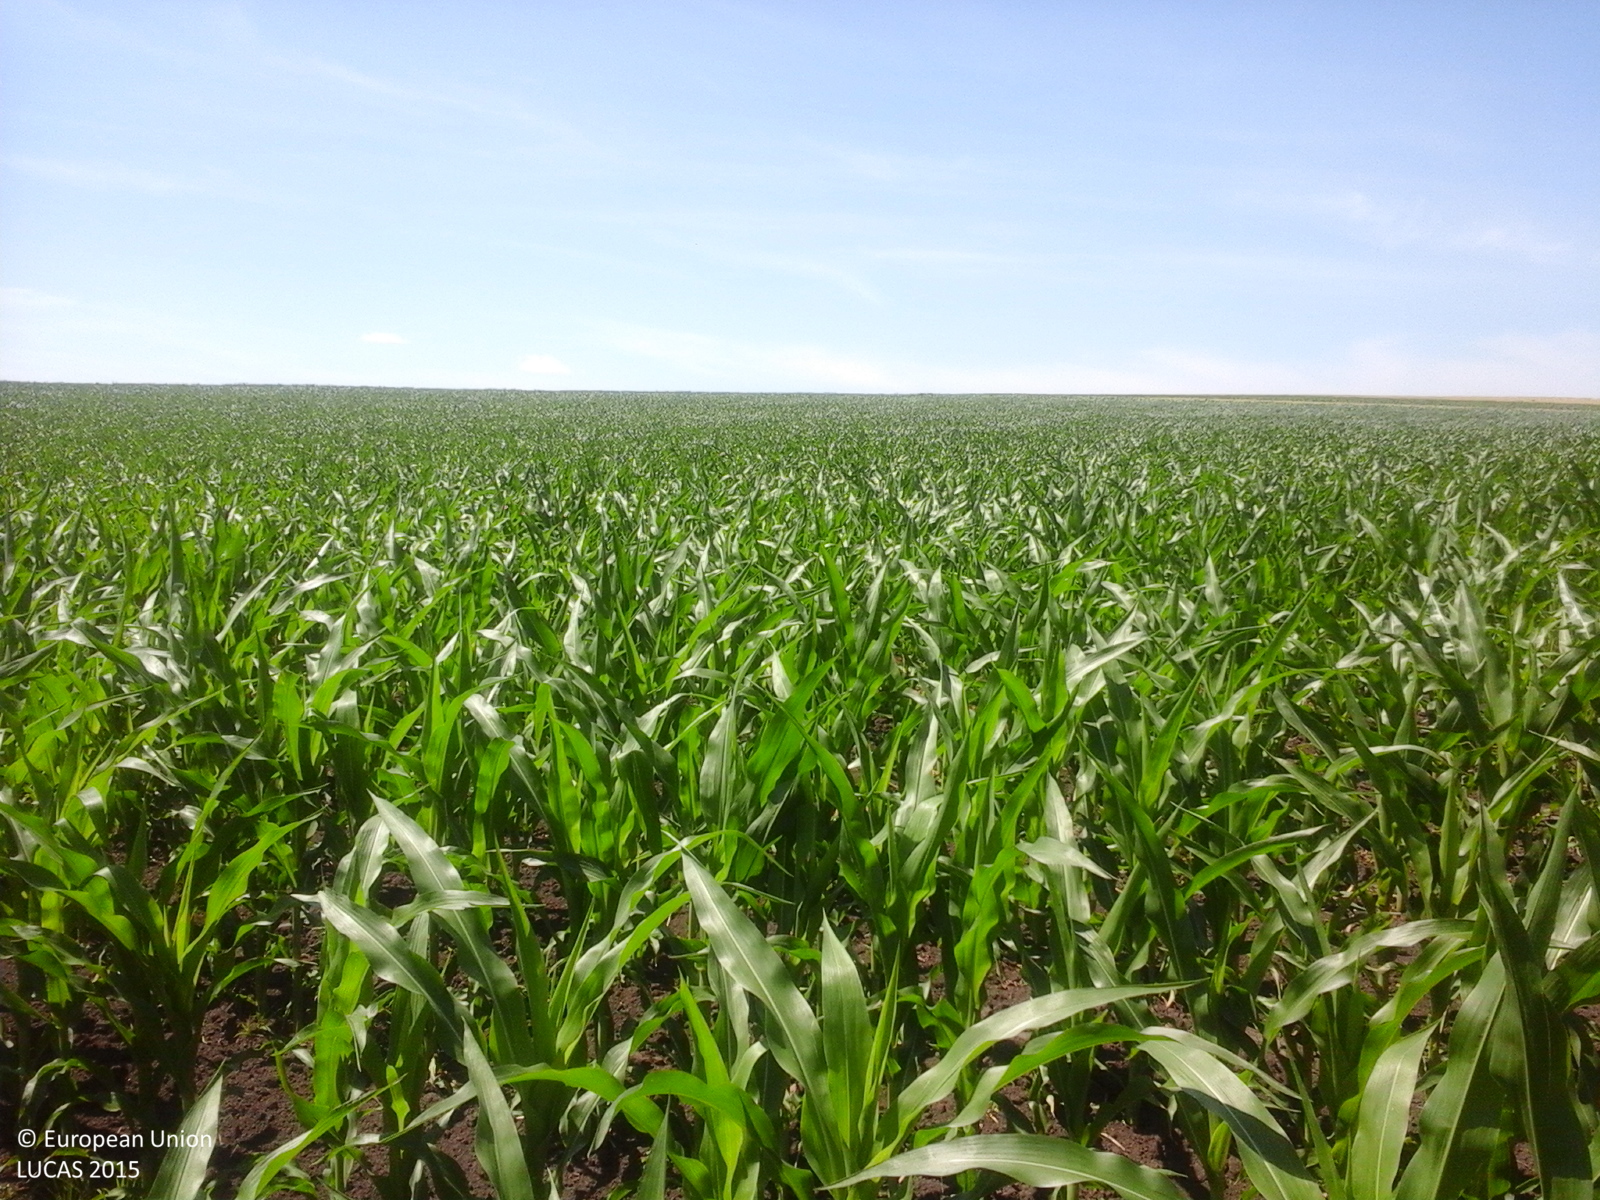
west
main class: Cropland
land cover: Maize
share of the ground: > 75 %
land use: Agriculture (excluding fallow land and kitchen gardens)
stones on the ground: < 10 %
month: June
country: RO
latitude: 47.7244
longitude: 27.1885
